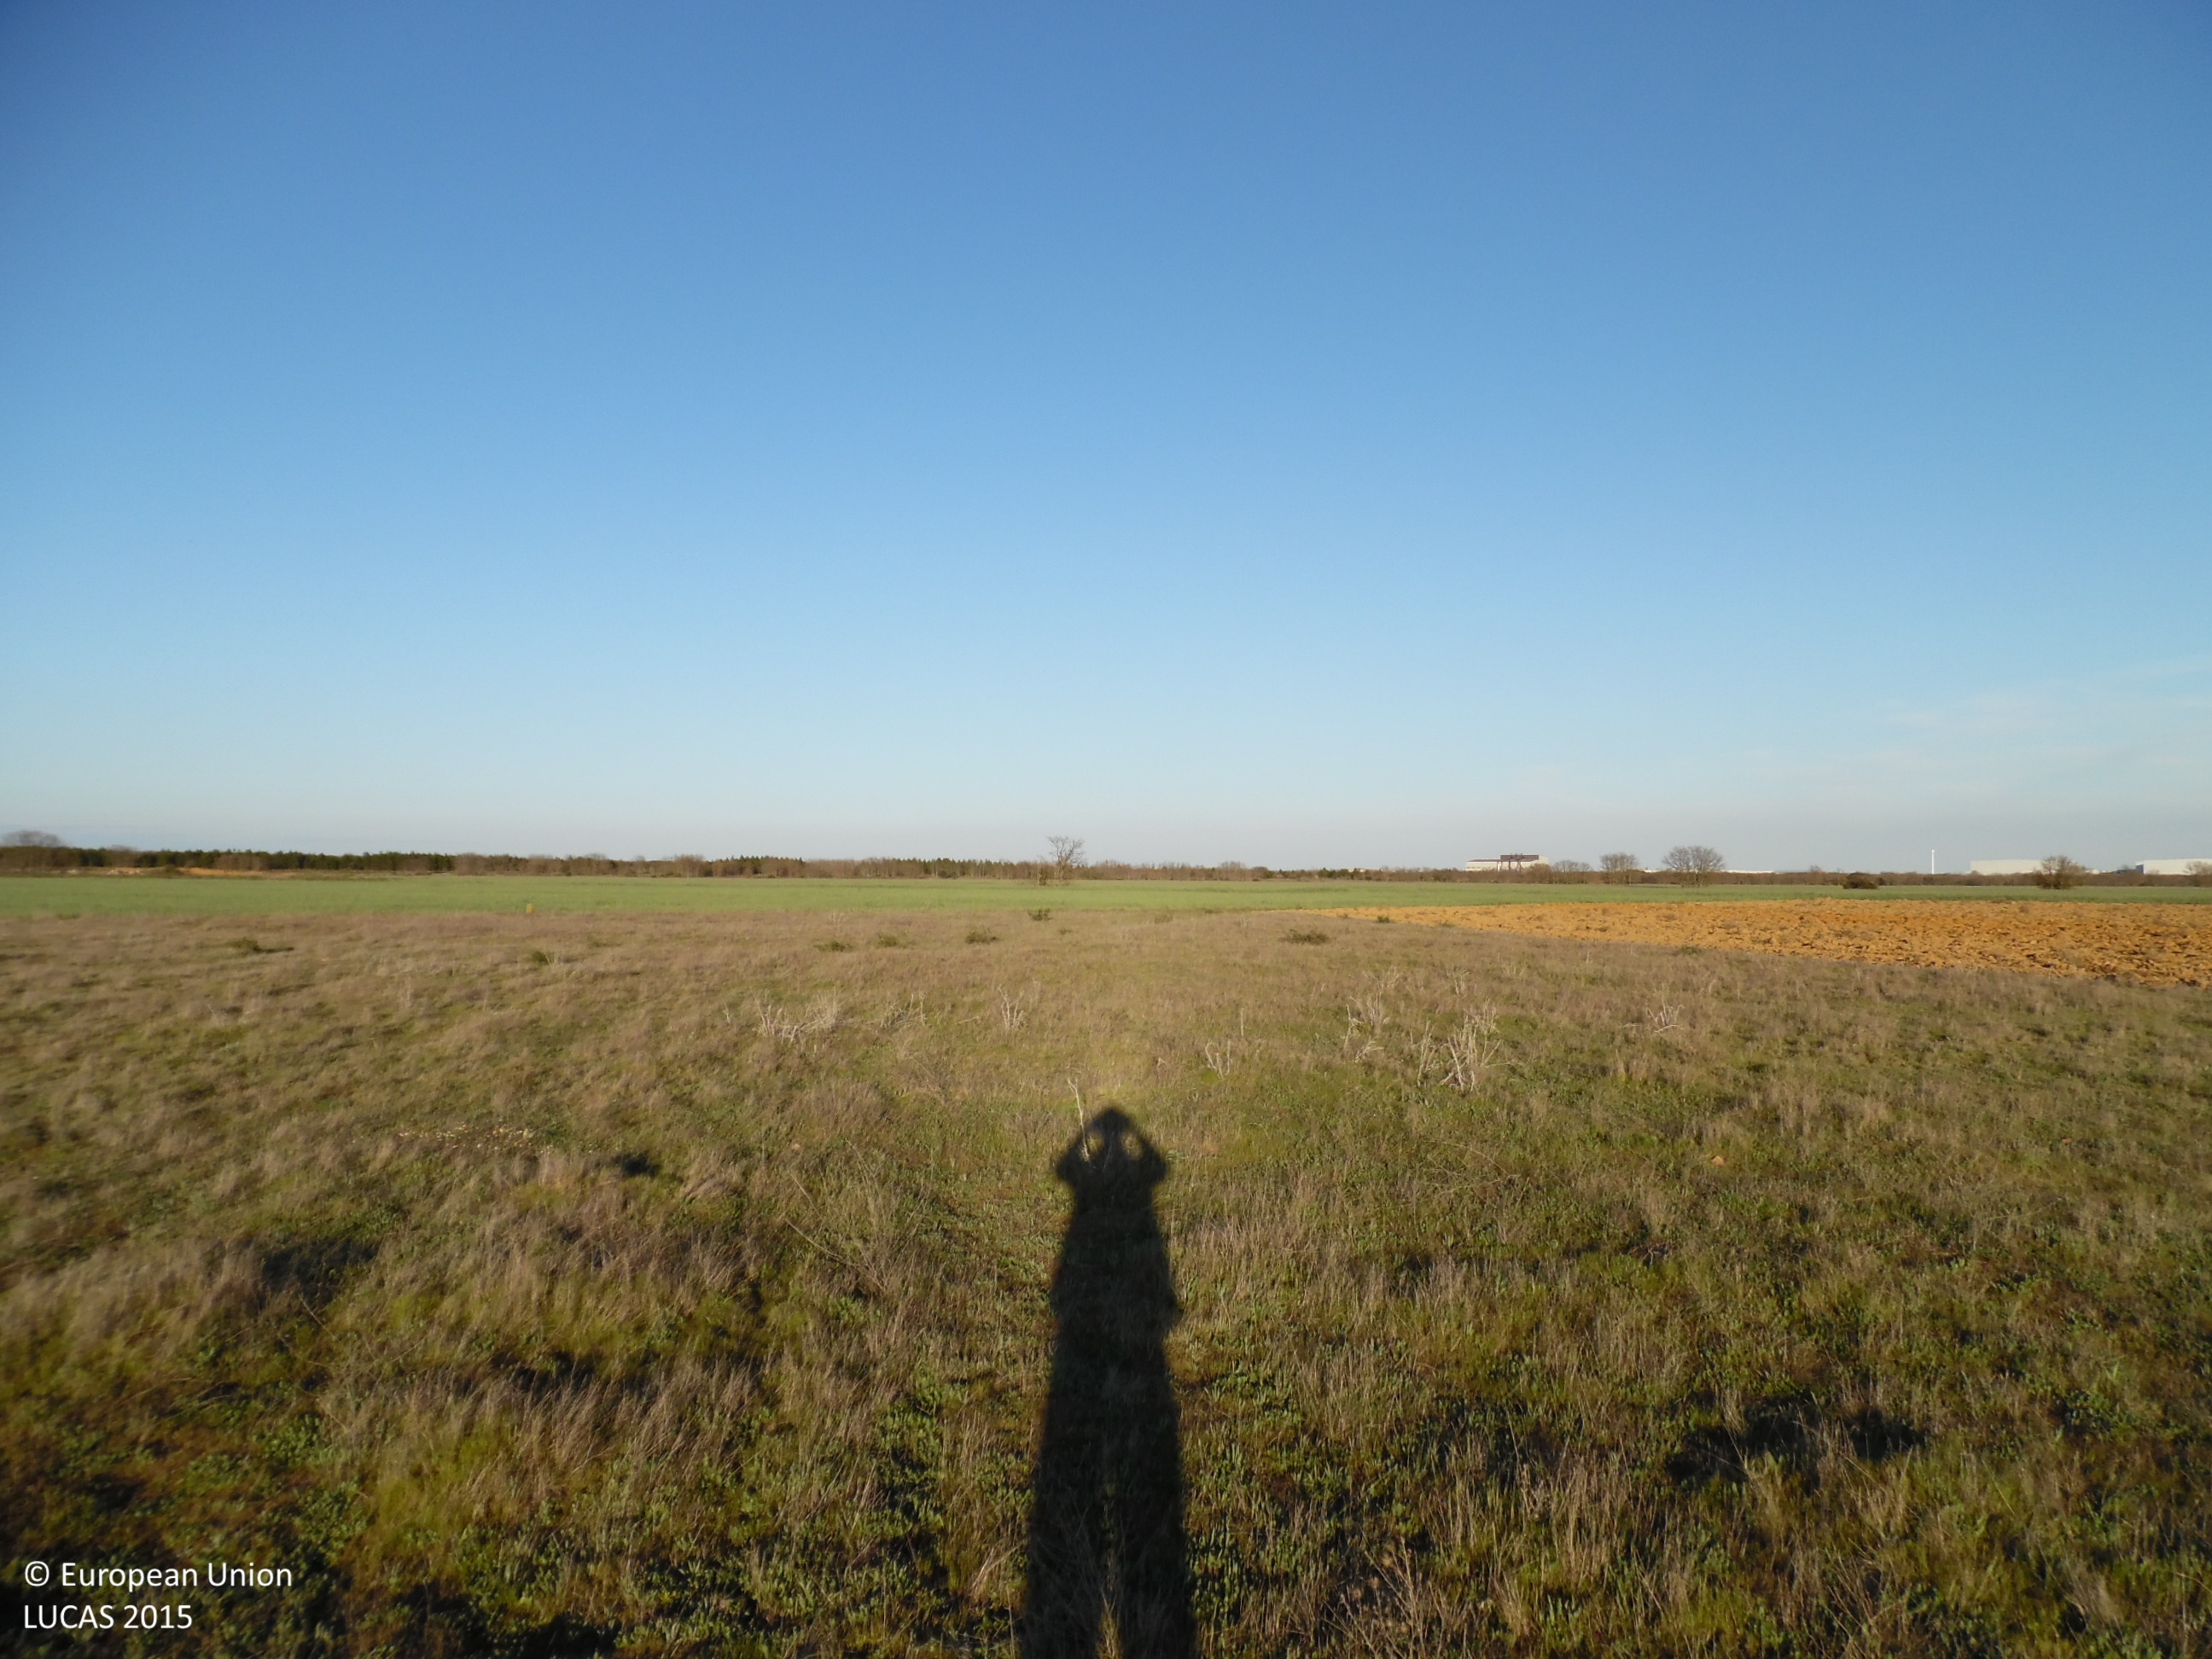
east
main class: Grassland
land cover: Spontaneously vegetated surfaces
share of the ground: > 75 %
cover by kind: herbaceous plants 95 %, shrubs 5 %
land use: Fallow land
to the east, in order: Spontaneously vegetated surfaces; Barley; Grass margins; Tracks; Grass margins; Barley
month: April
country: ES
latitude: 42.5476
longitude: -5.7736
